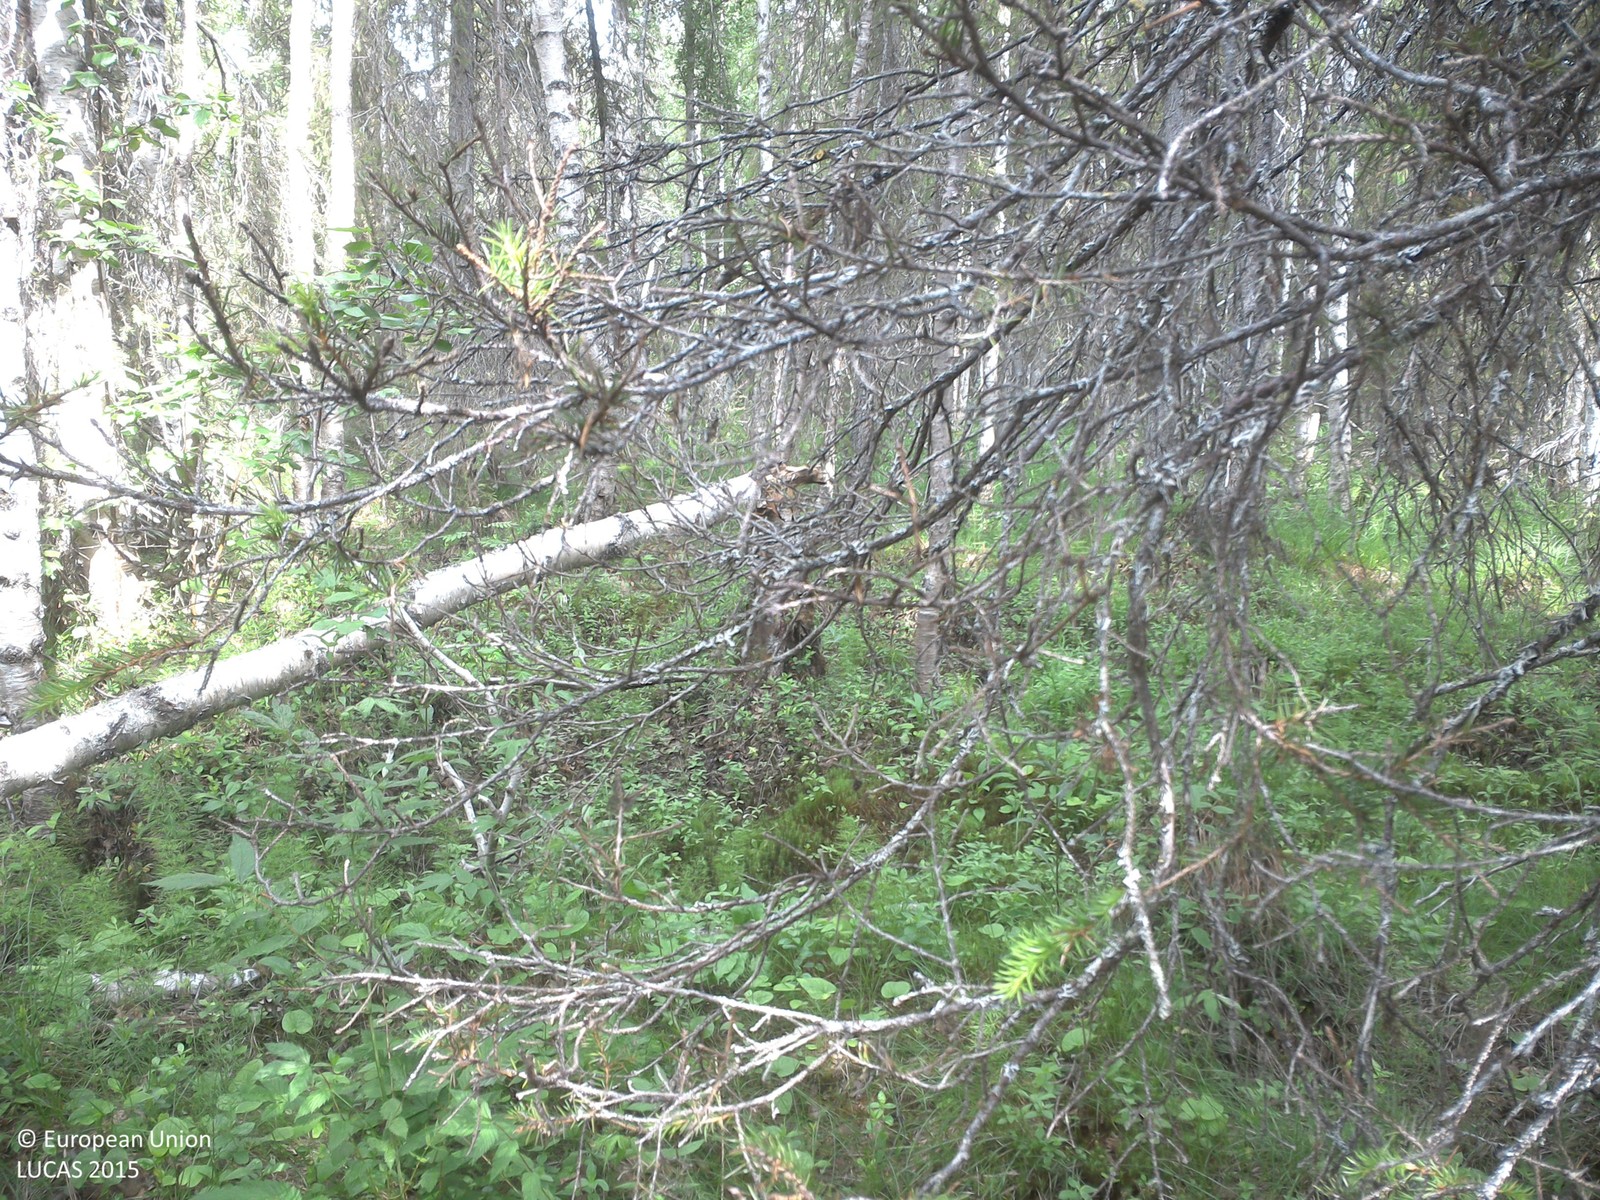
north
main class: Woodland
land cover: Spruce dominated mixed woodland
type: boreal forest
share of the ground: 50 - 75 %
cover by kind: shrubs 40 %, coniferous forest trees 30 %, broadleaved forest trees 15 %, herbaceous plants 15 %
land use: Forestry
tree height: > 5 m
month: July
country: SE
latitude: 67.4917
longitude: 23.3807
